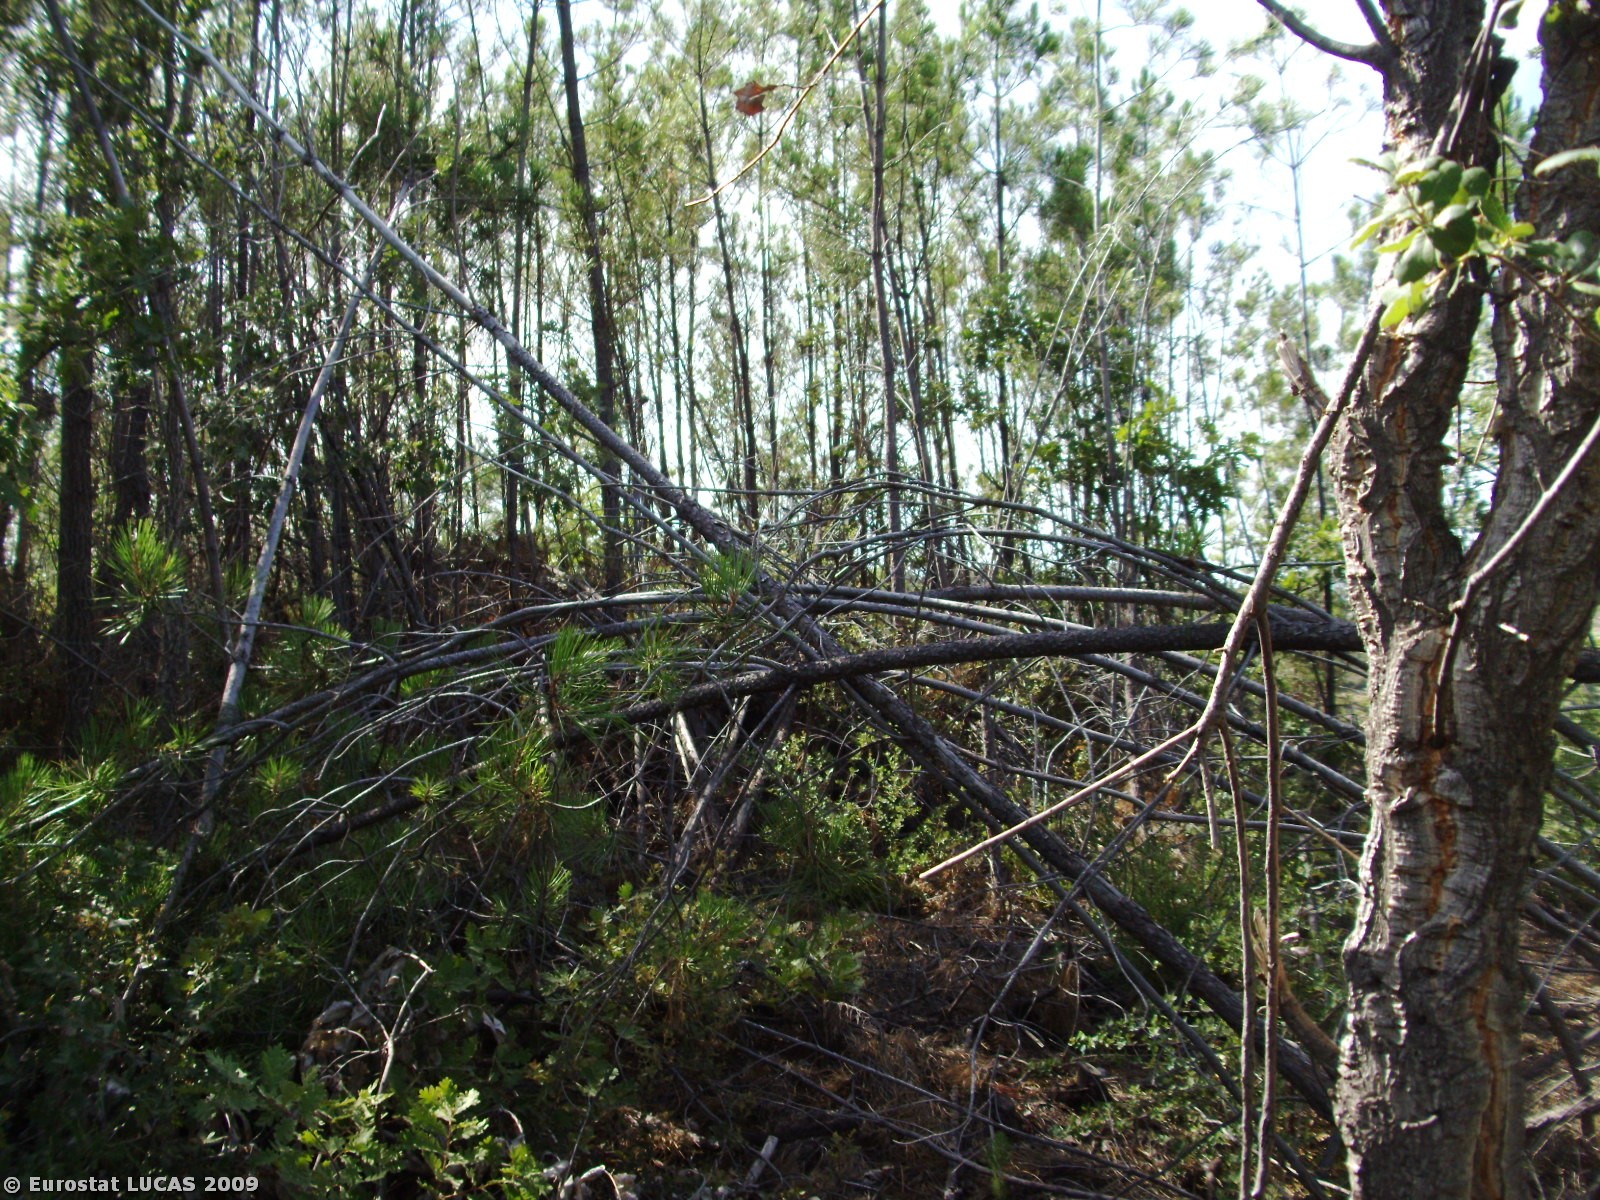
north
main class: Woodland
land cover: Coniferous woodland
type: coniferous forest of the mediterranean region
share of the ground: 25 - 50 %
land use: Forestry
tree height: > 5 m
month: July
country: PT
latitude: 40.2484
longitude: -7.3008
